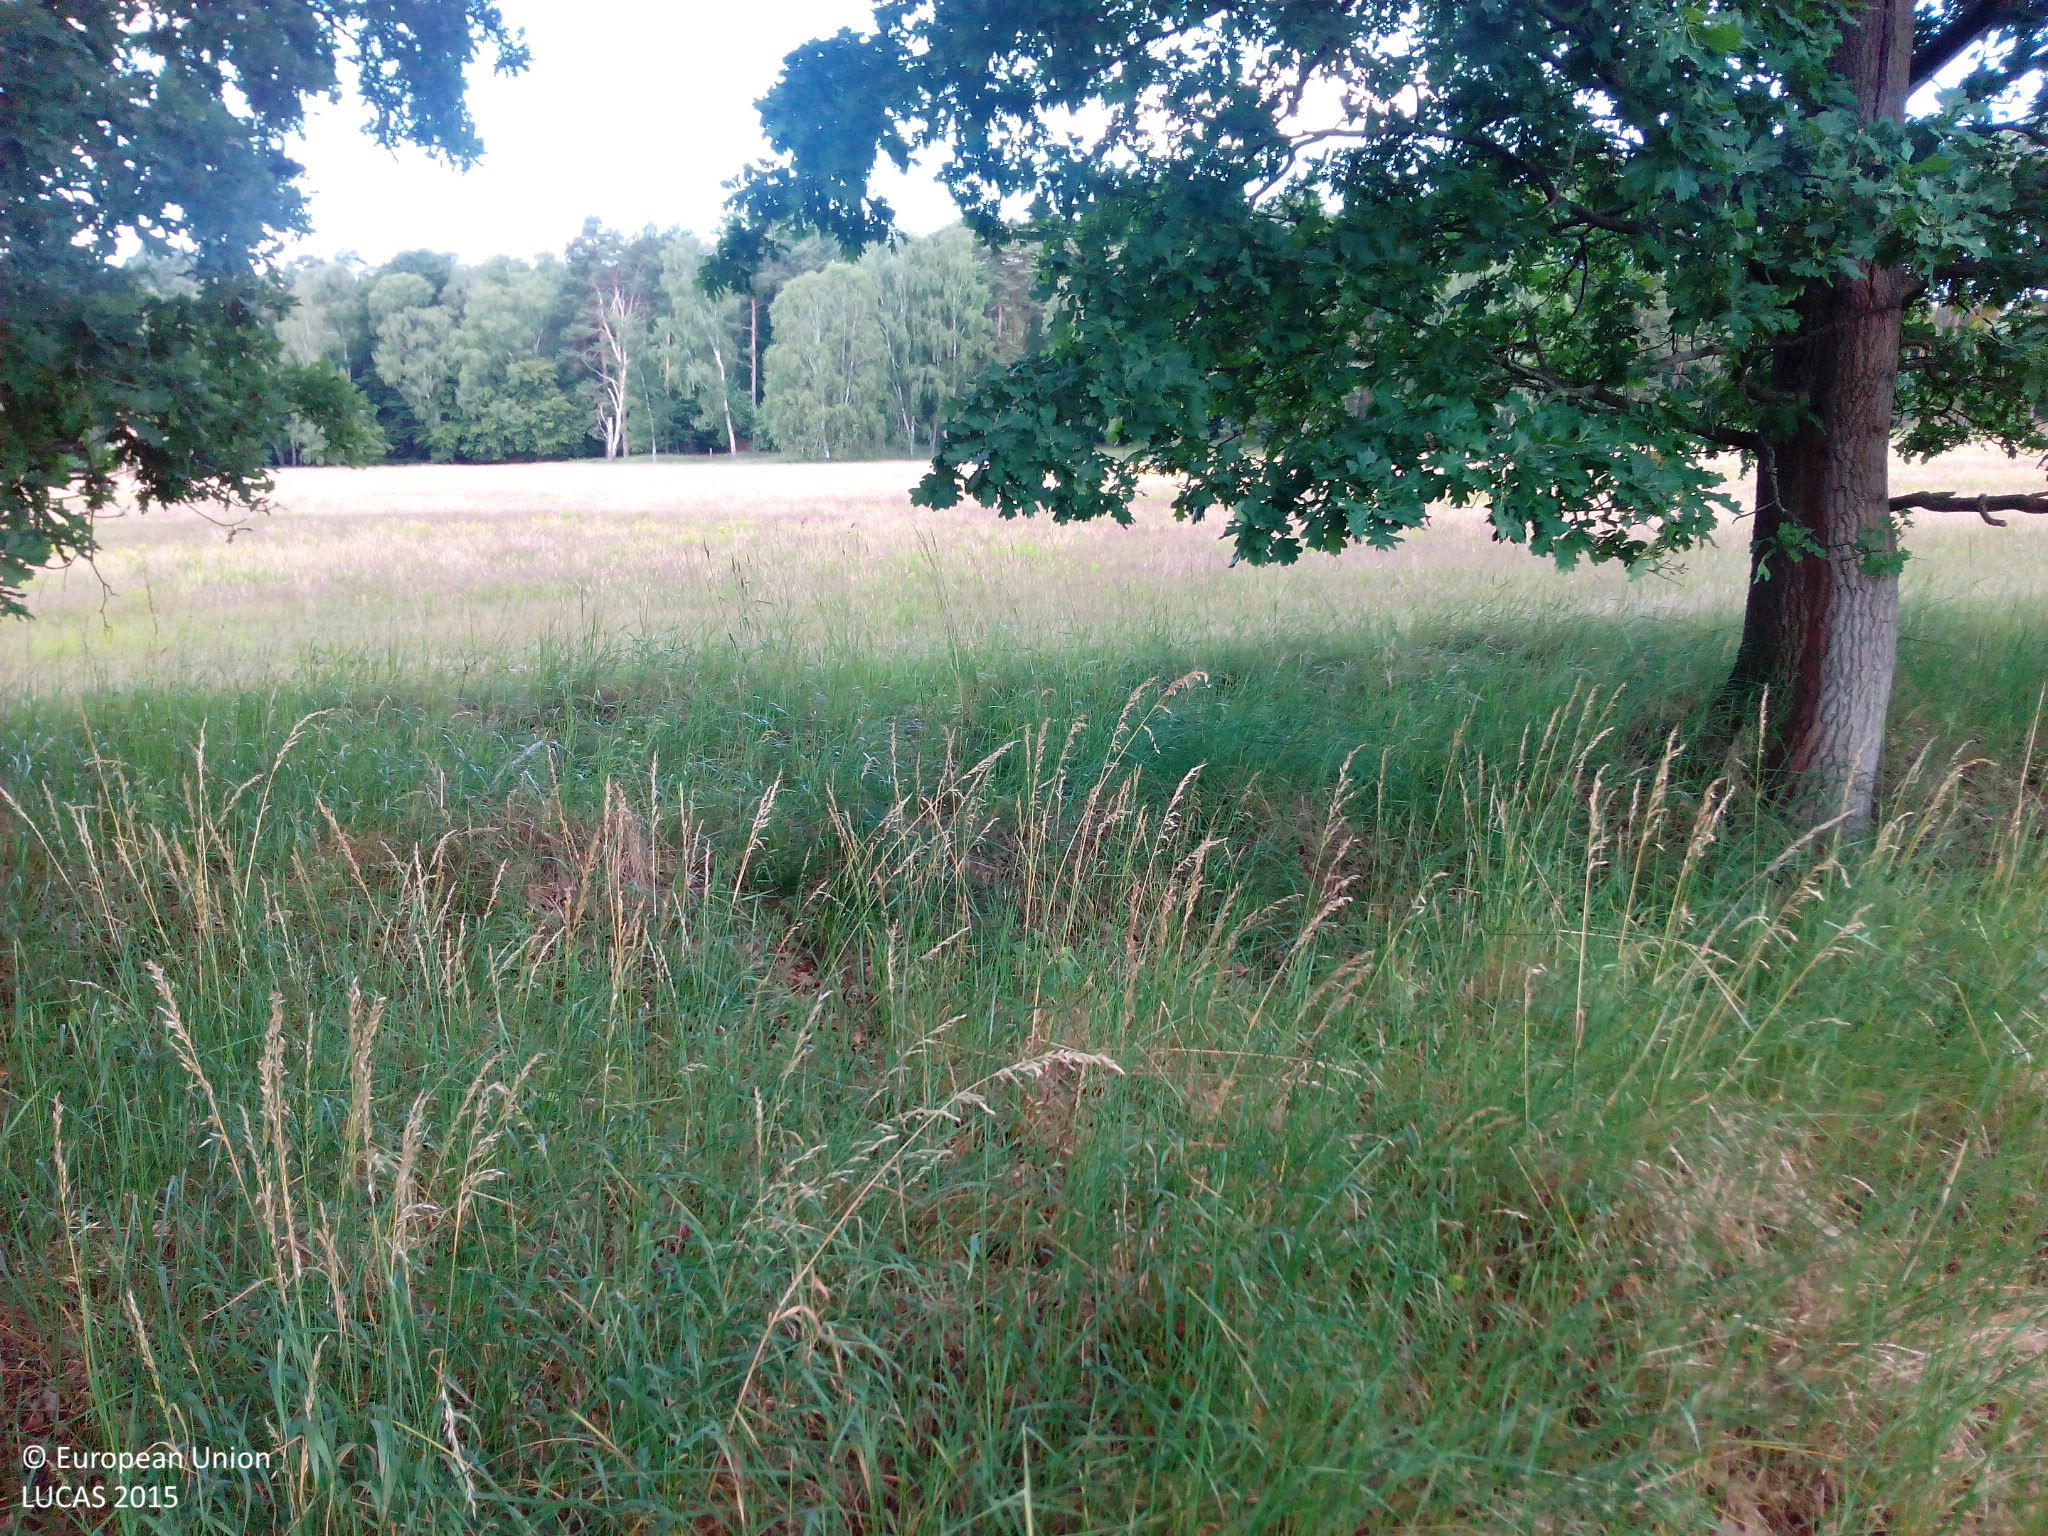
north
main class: Woodland
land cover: Broadleaved woodland
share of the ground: > 75 %
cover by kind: broadleaved forest trees 75 %, herbaceous plants 25 %
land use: Agriculture (excluding fallow land and kitchen gardens)
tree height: > 5 m
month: June
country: DE
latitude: 52.8211
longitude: 13.1606
